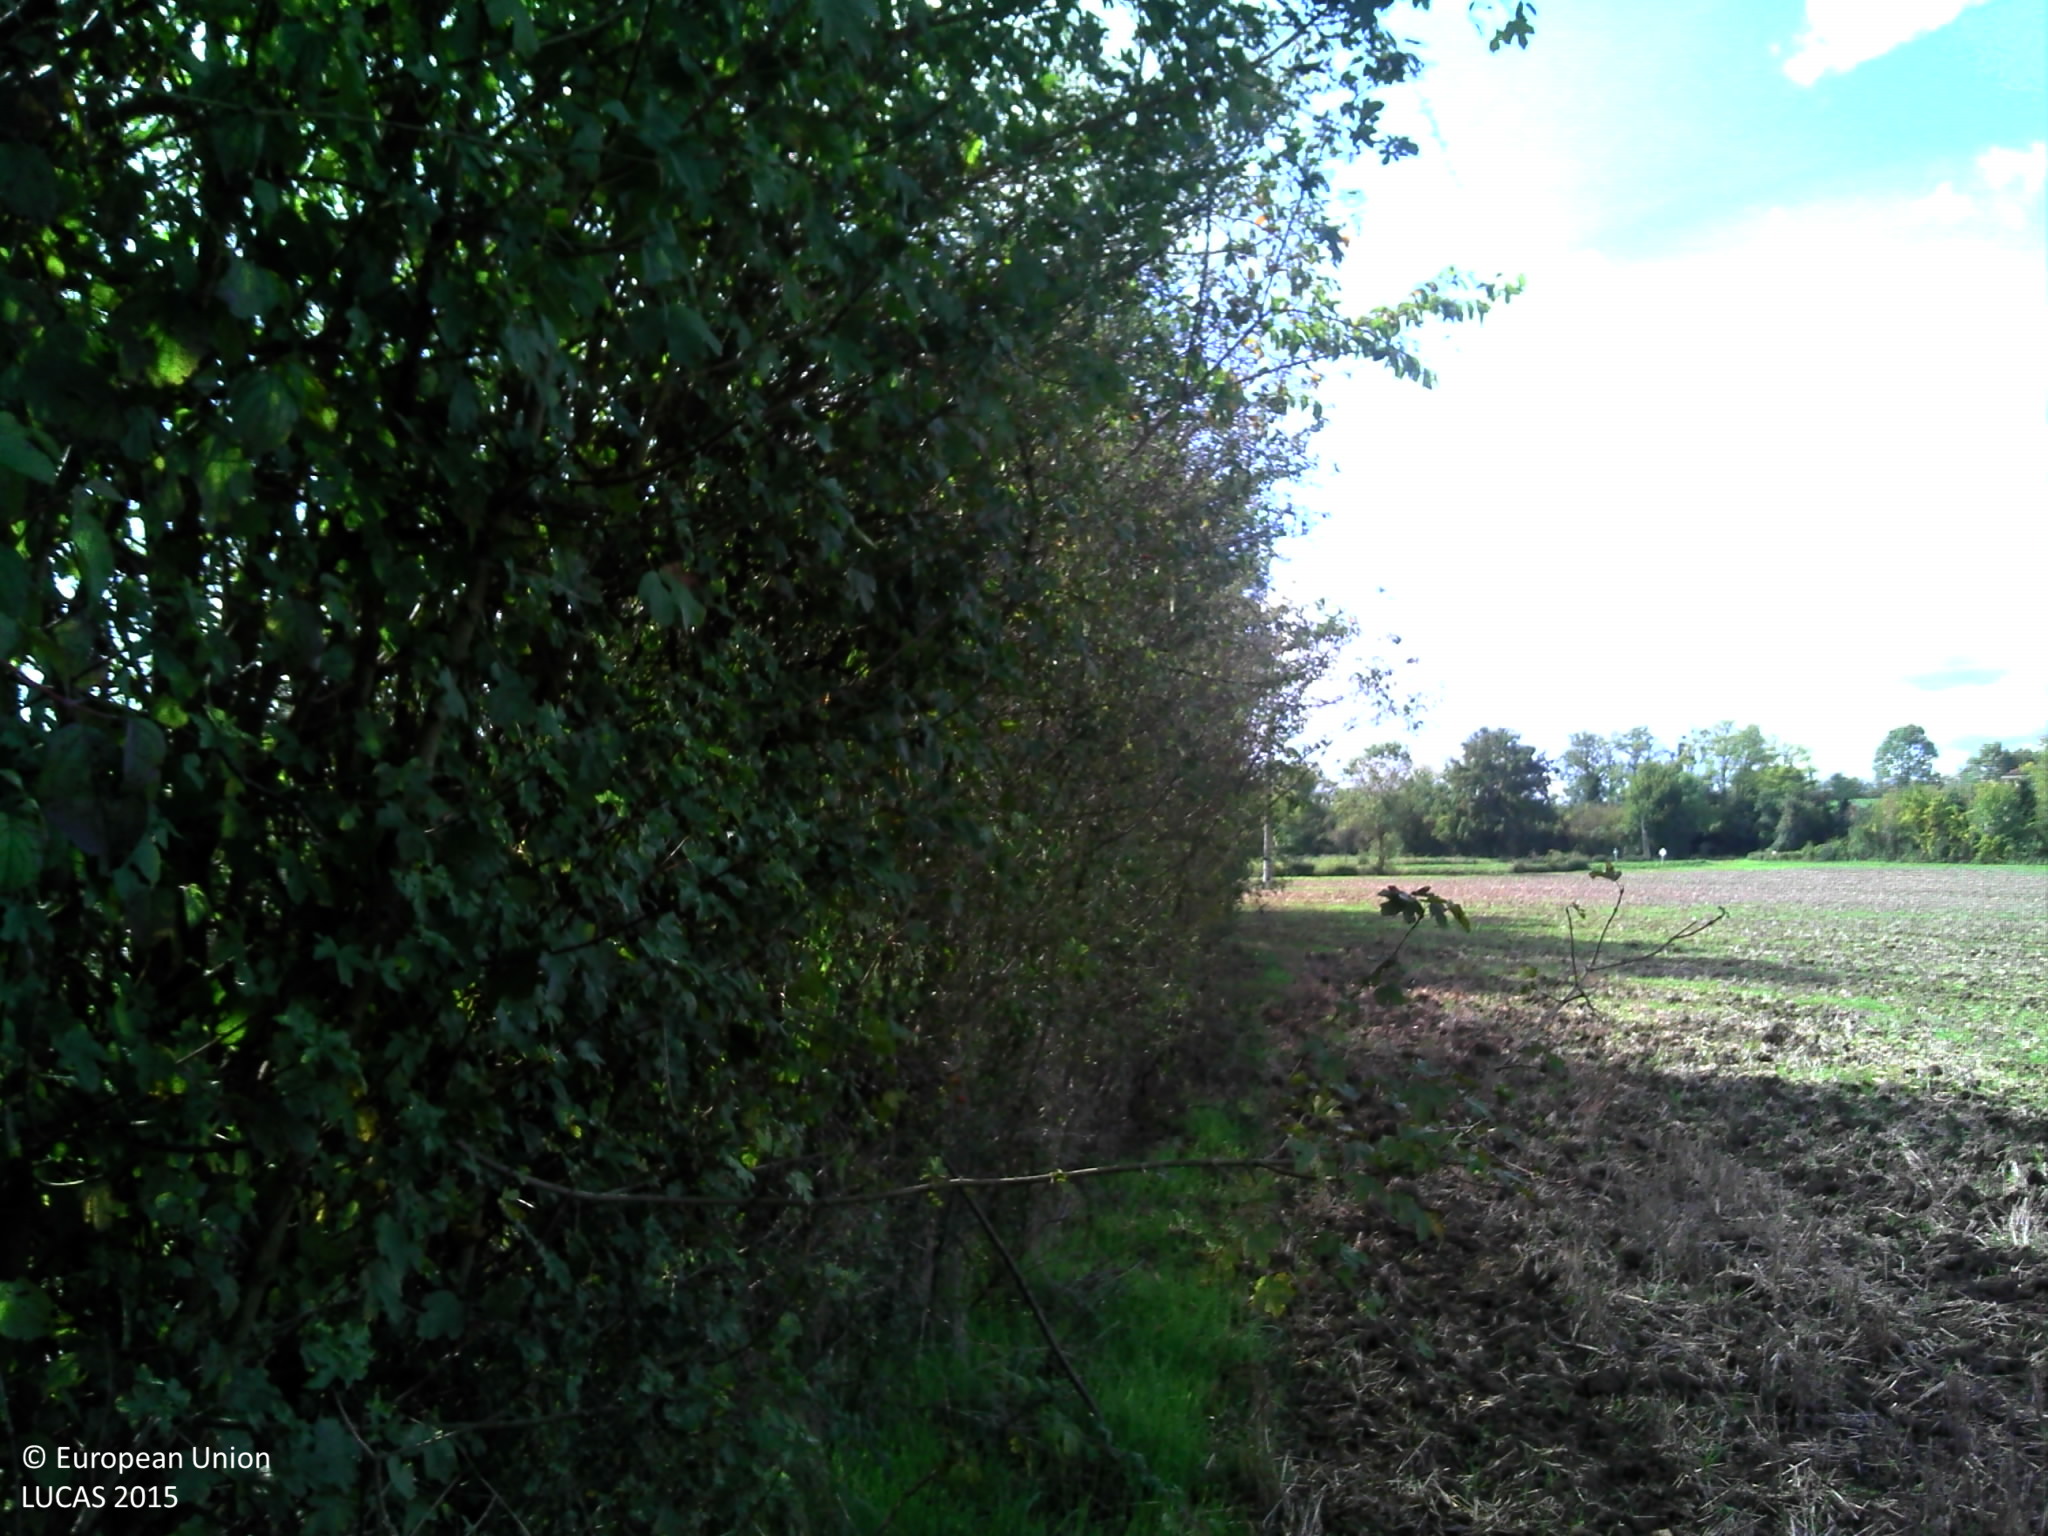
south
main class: Grassland
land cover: Grassland without tree/shrub cover
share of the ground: > 75 %
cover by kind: herbaceous plants 100 %
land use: Agriculture (excluding fallow land and kitchen gardens)
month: October
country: FR
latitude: 46.3665
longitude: 5.1281
